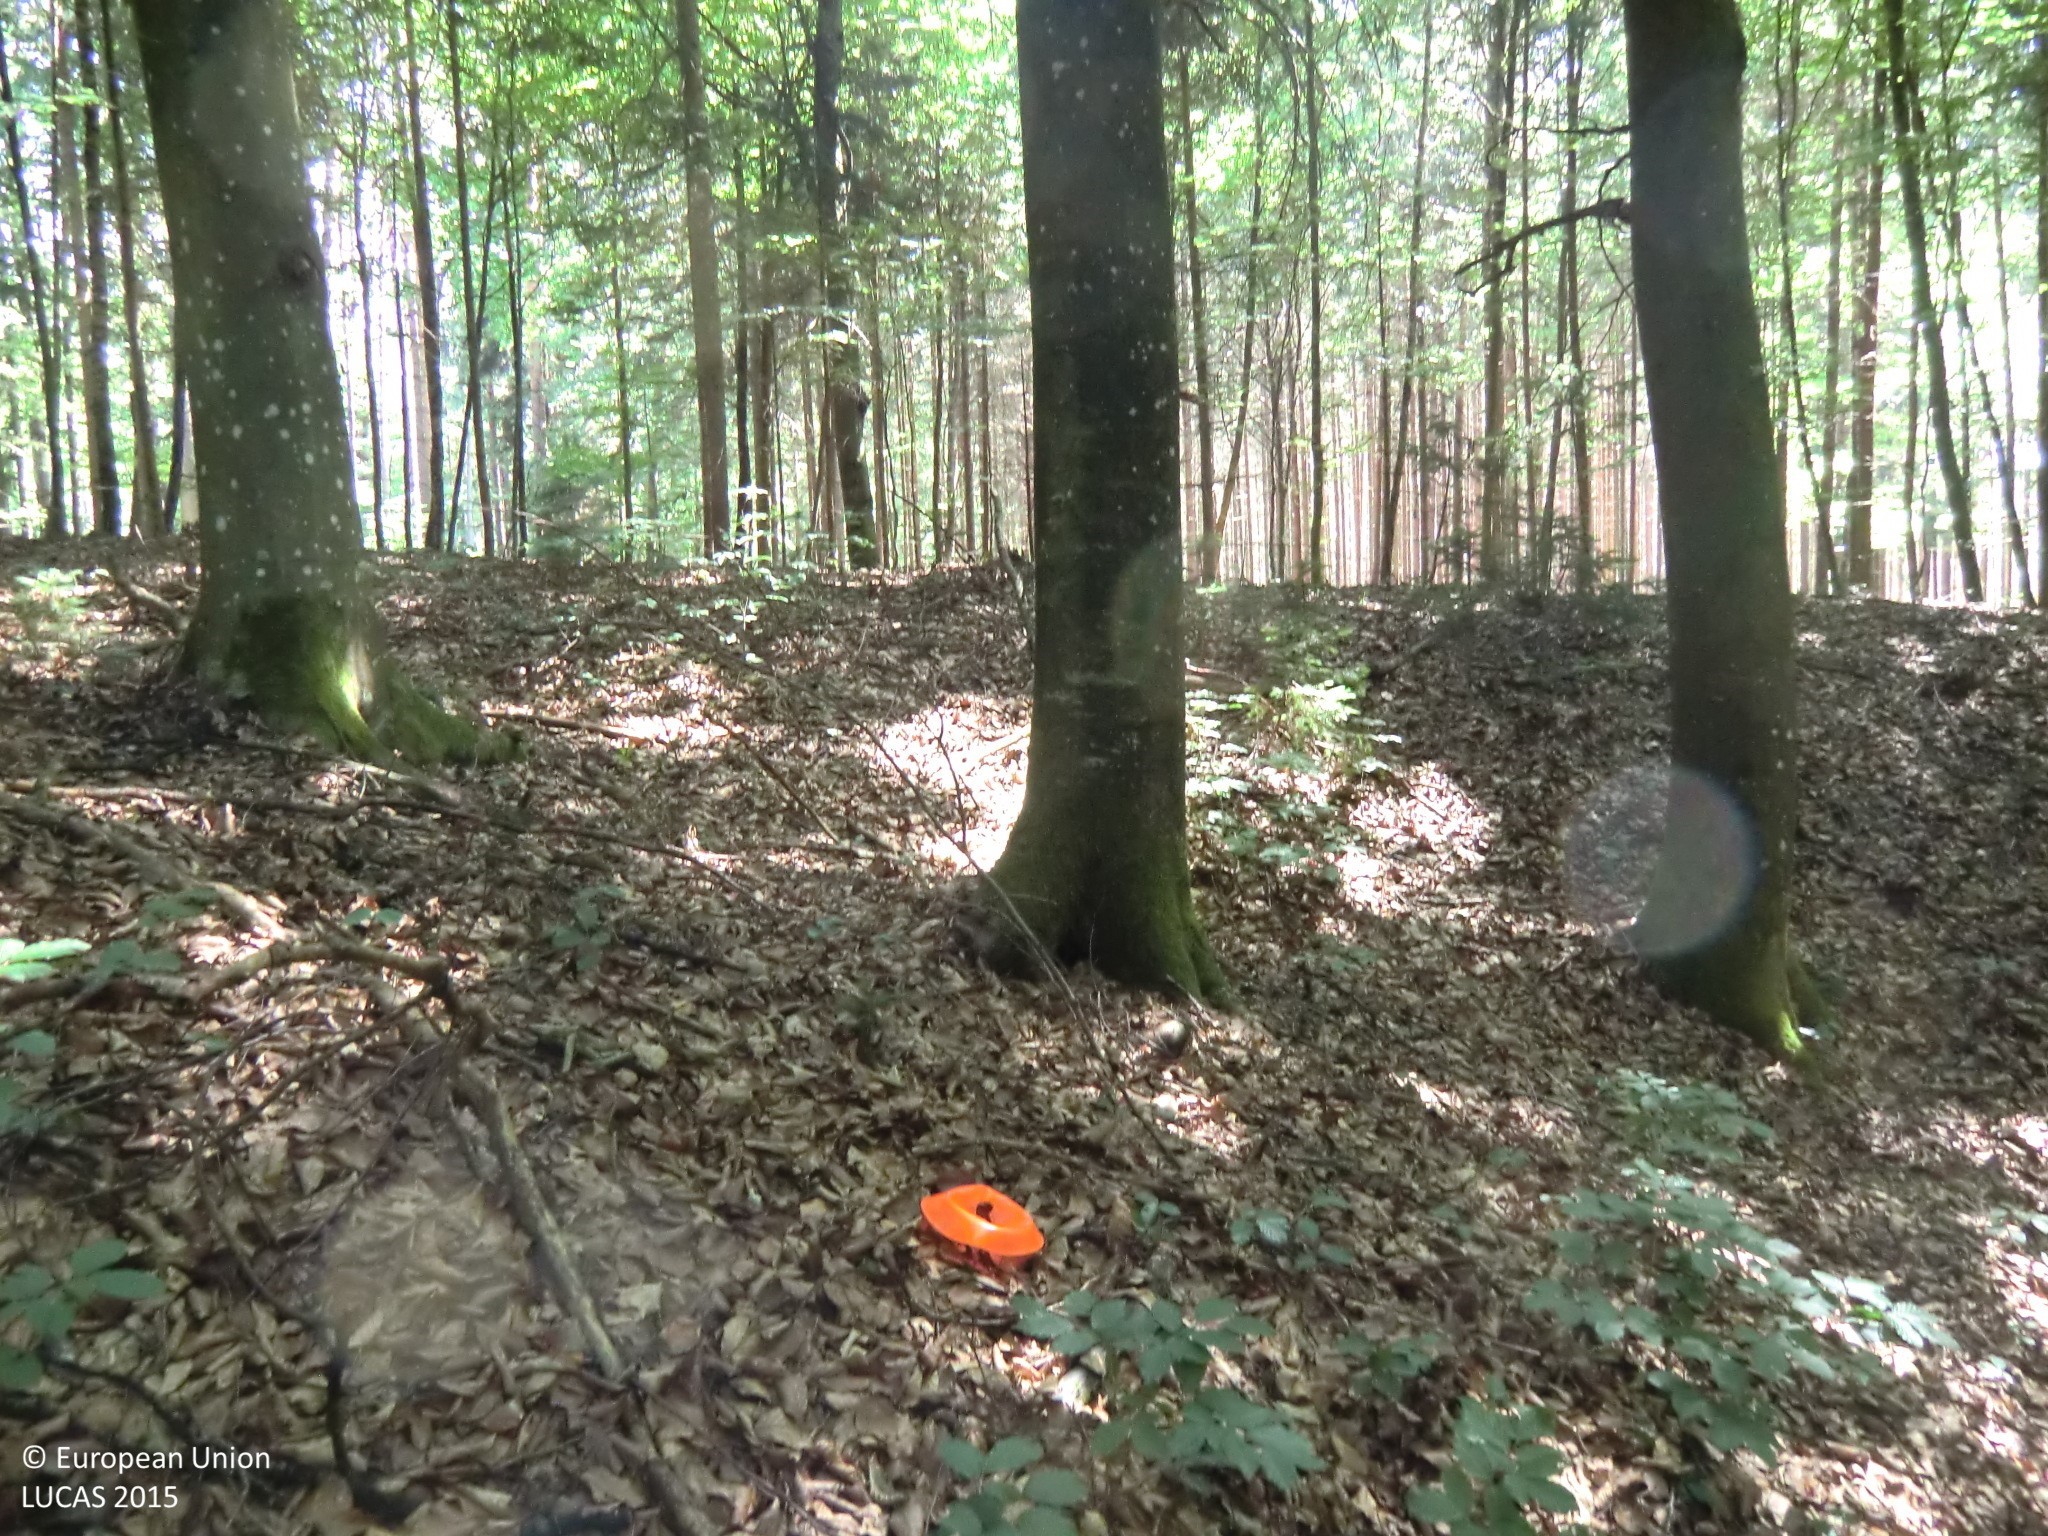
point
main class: Woodland
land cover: Broadleaved woodland
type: beech forest
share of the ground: > 75 %
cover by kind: broadleaved forest trees 90 %, coniferous forest trees 5 %, unconsolidated bare surface 5 %
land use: Forestry
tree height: > 5 m
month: July
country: AT
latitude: 47.2158
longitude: 15.9301
